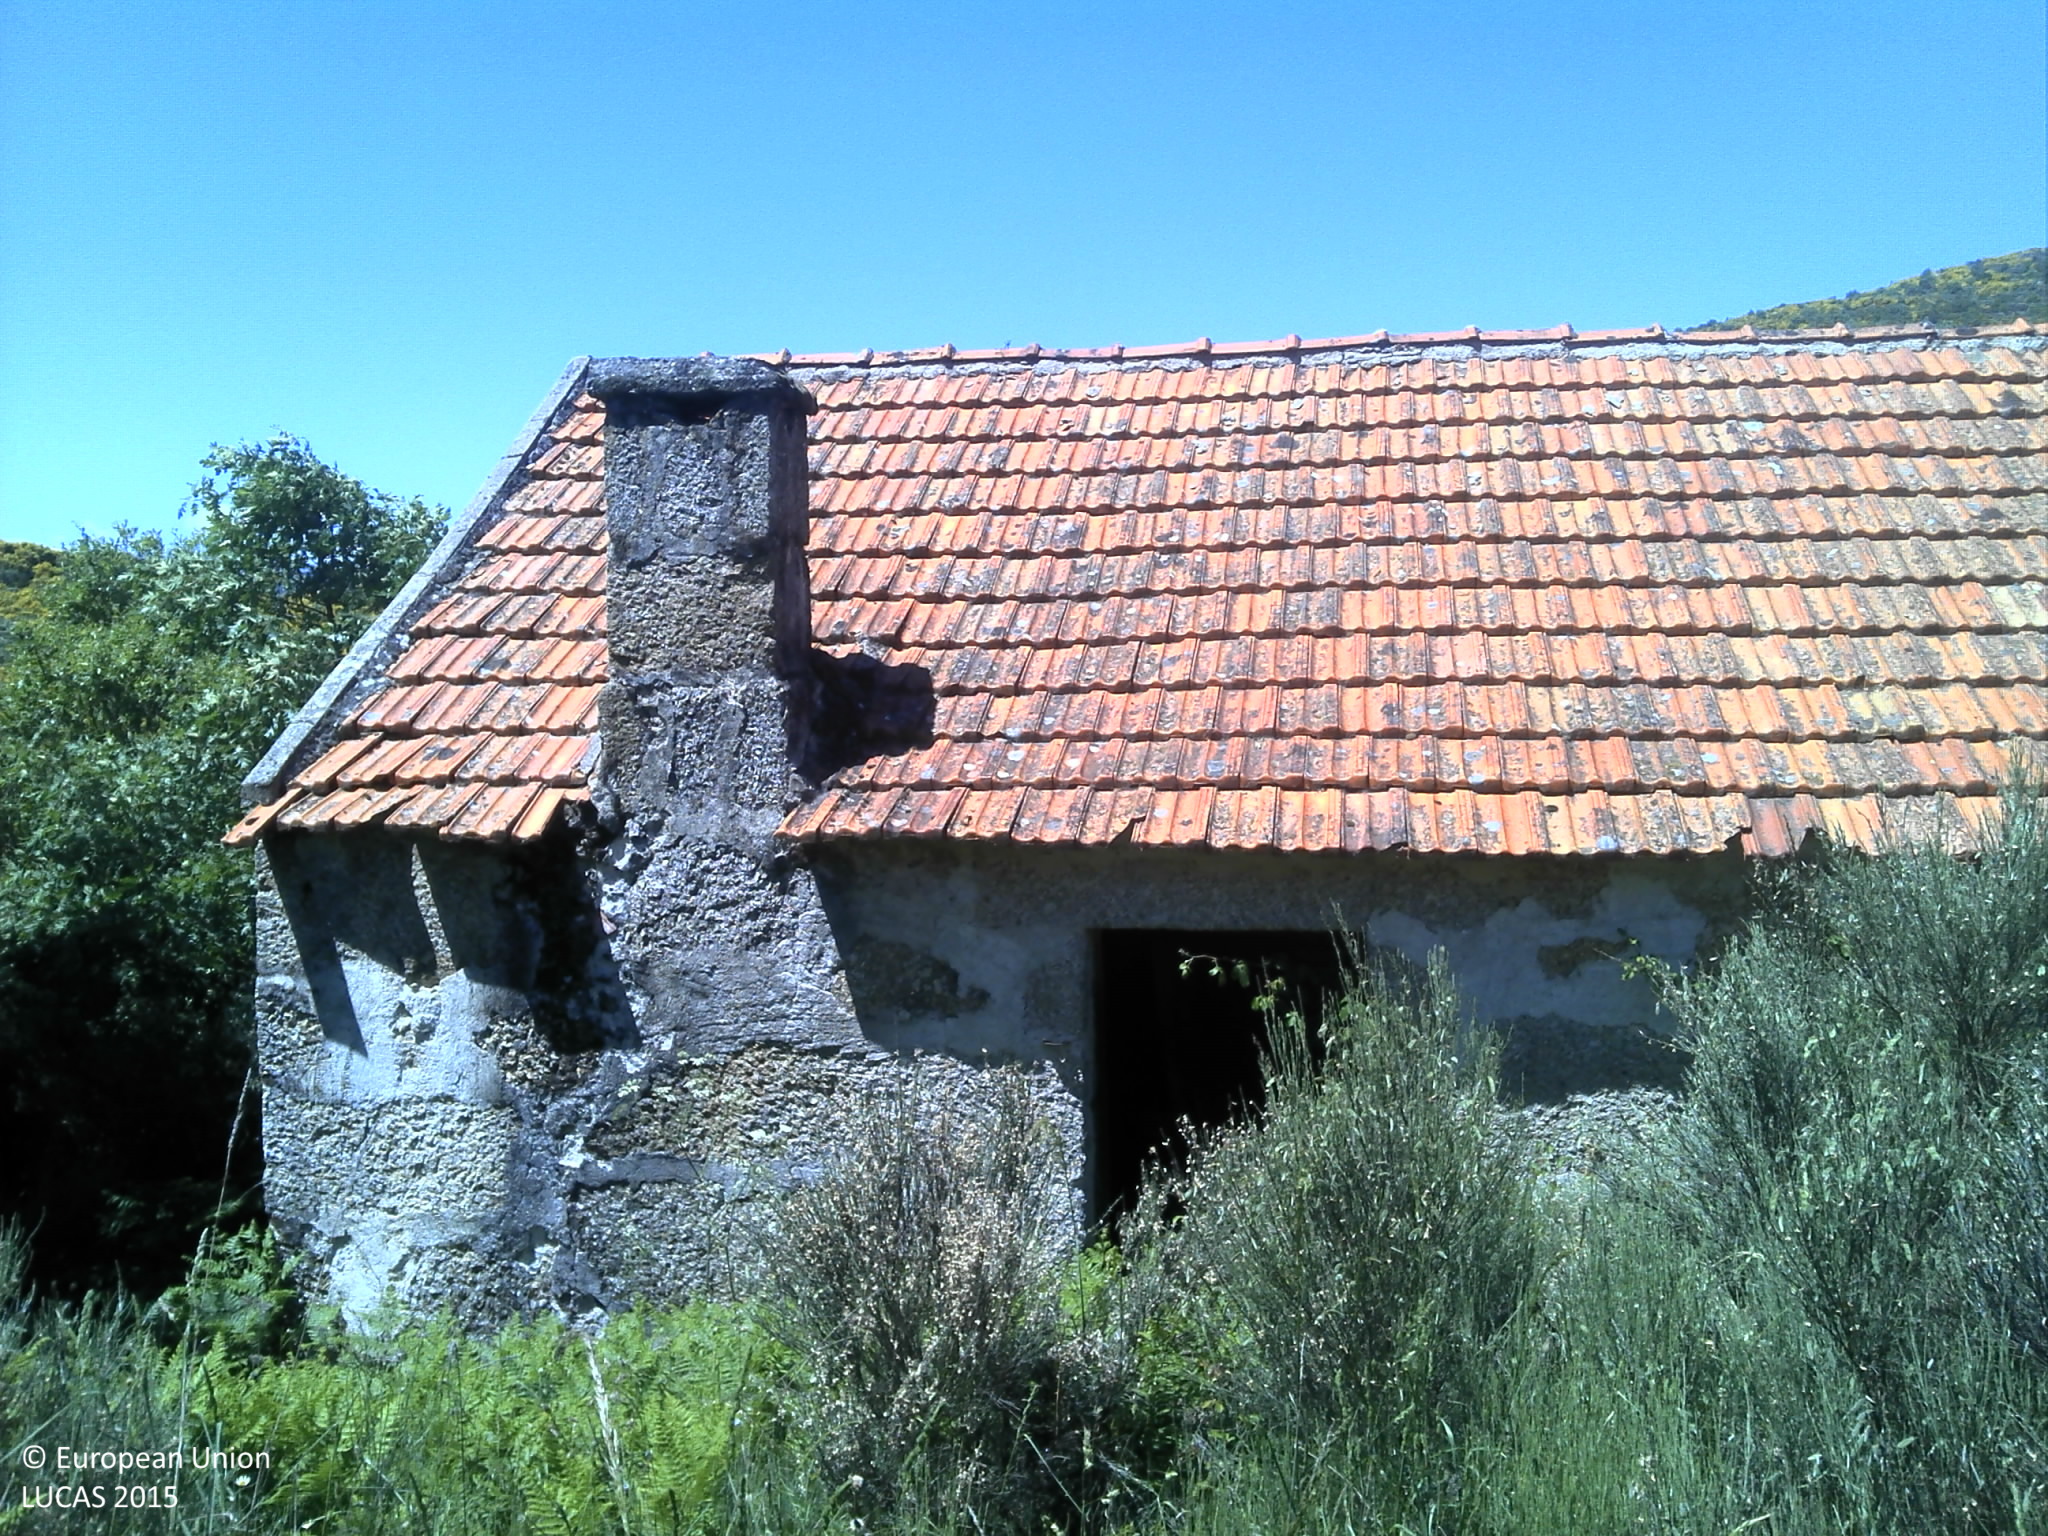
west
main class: Shrubland
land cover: Shrubland with sparse tree cover
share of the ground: > 75 %
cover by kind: shrubs 80 %, unconsolidated bare surface 10 %, broadleaved forest trees 5 %, herbaceous plants 5 %
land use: Semi-natural and natural areas not in use
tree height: > 5 m
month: May
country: PT
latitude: 40.4592
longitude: -7.3594
